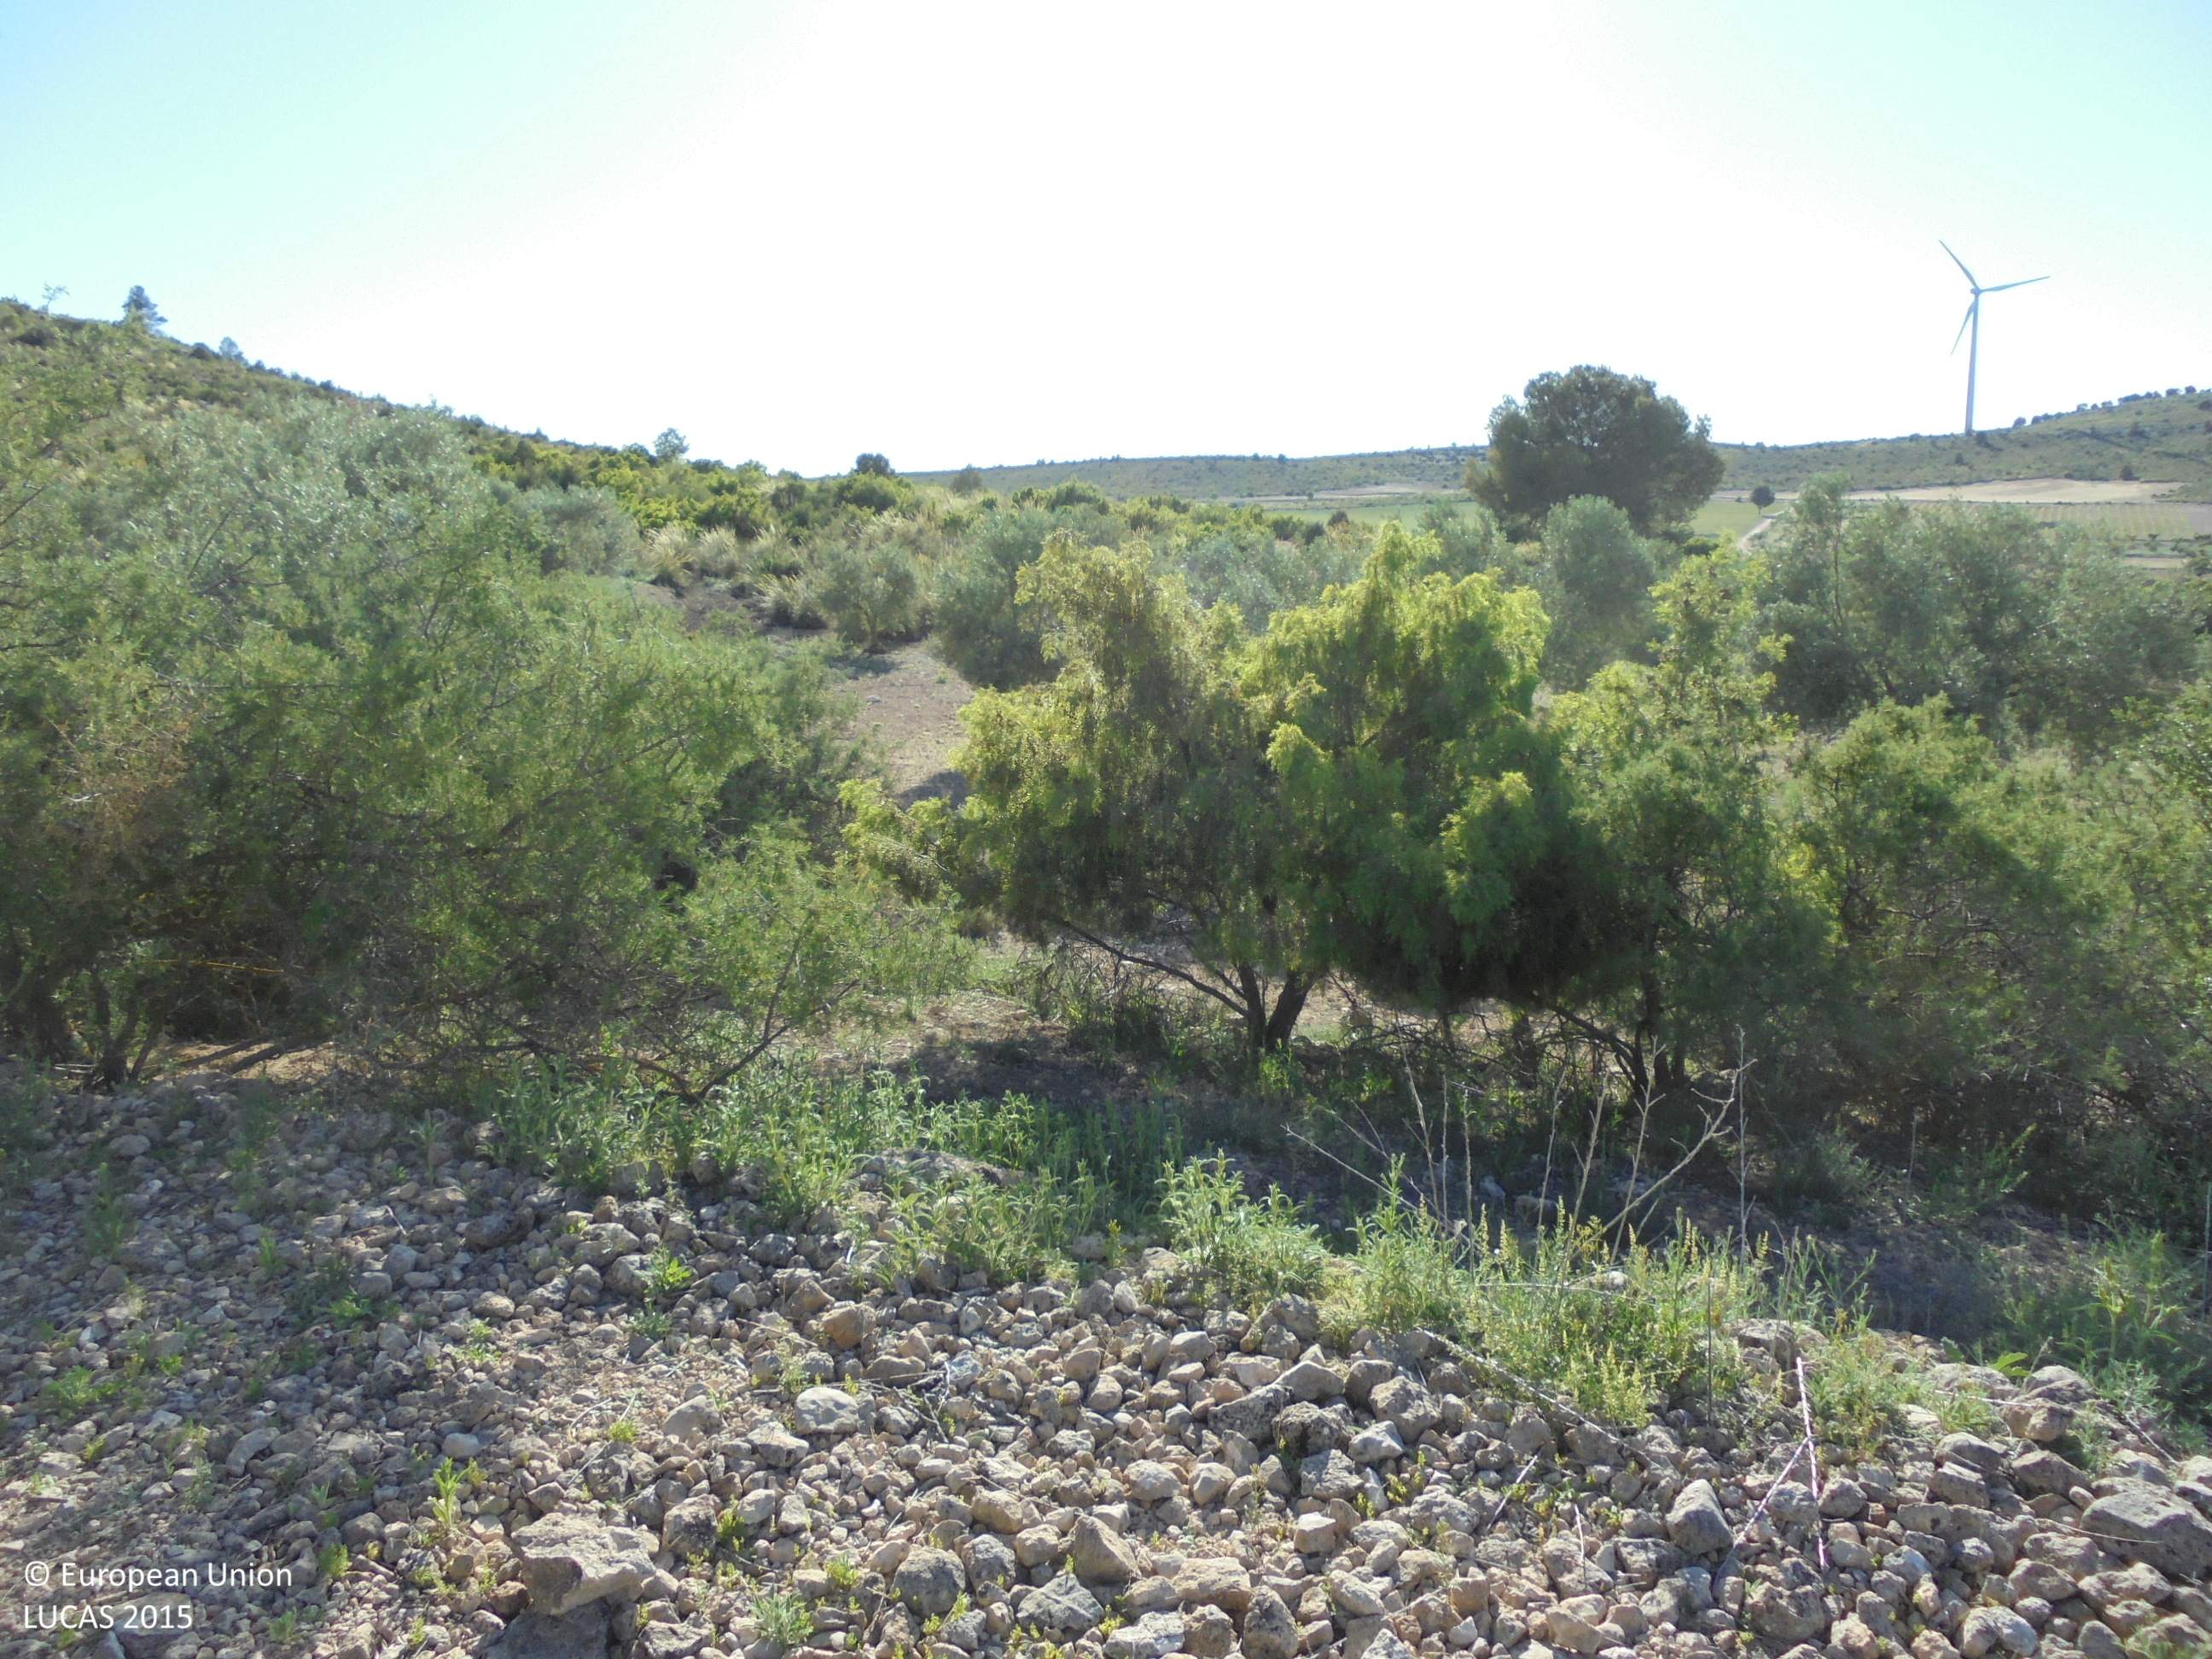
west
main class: Cropland
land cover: Olive groves
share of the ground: 10 - 25 %
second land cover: Spontaneously vegetated surfaces
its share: 50 - 75 %
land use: Agriculture (excluding fallow land and kitchen gardens)
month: May
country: ES
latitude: 39.0800
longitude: -1.4777
